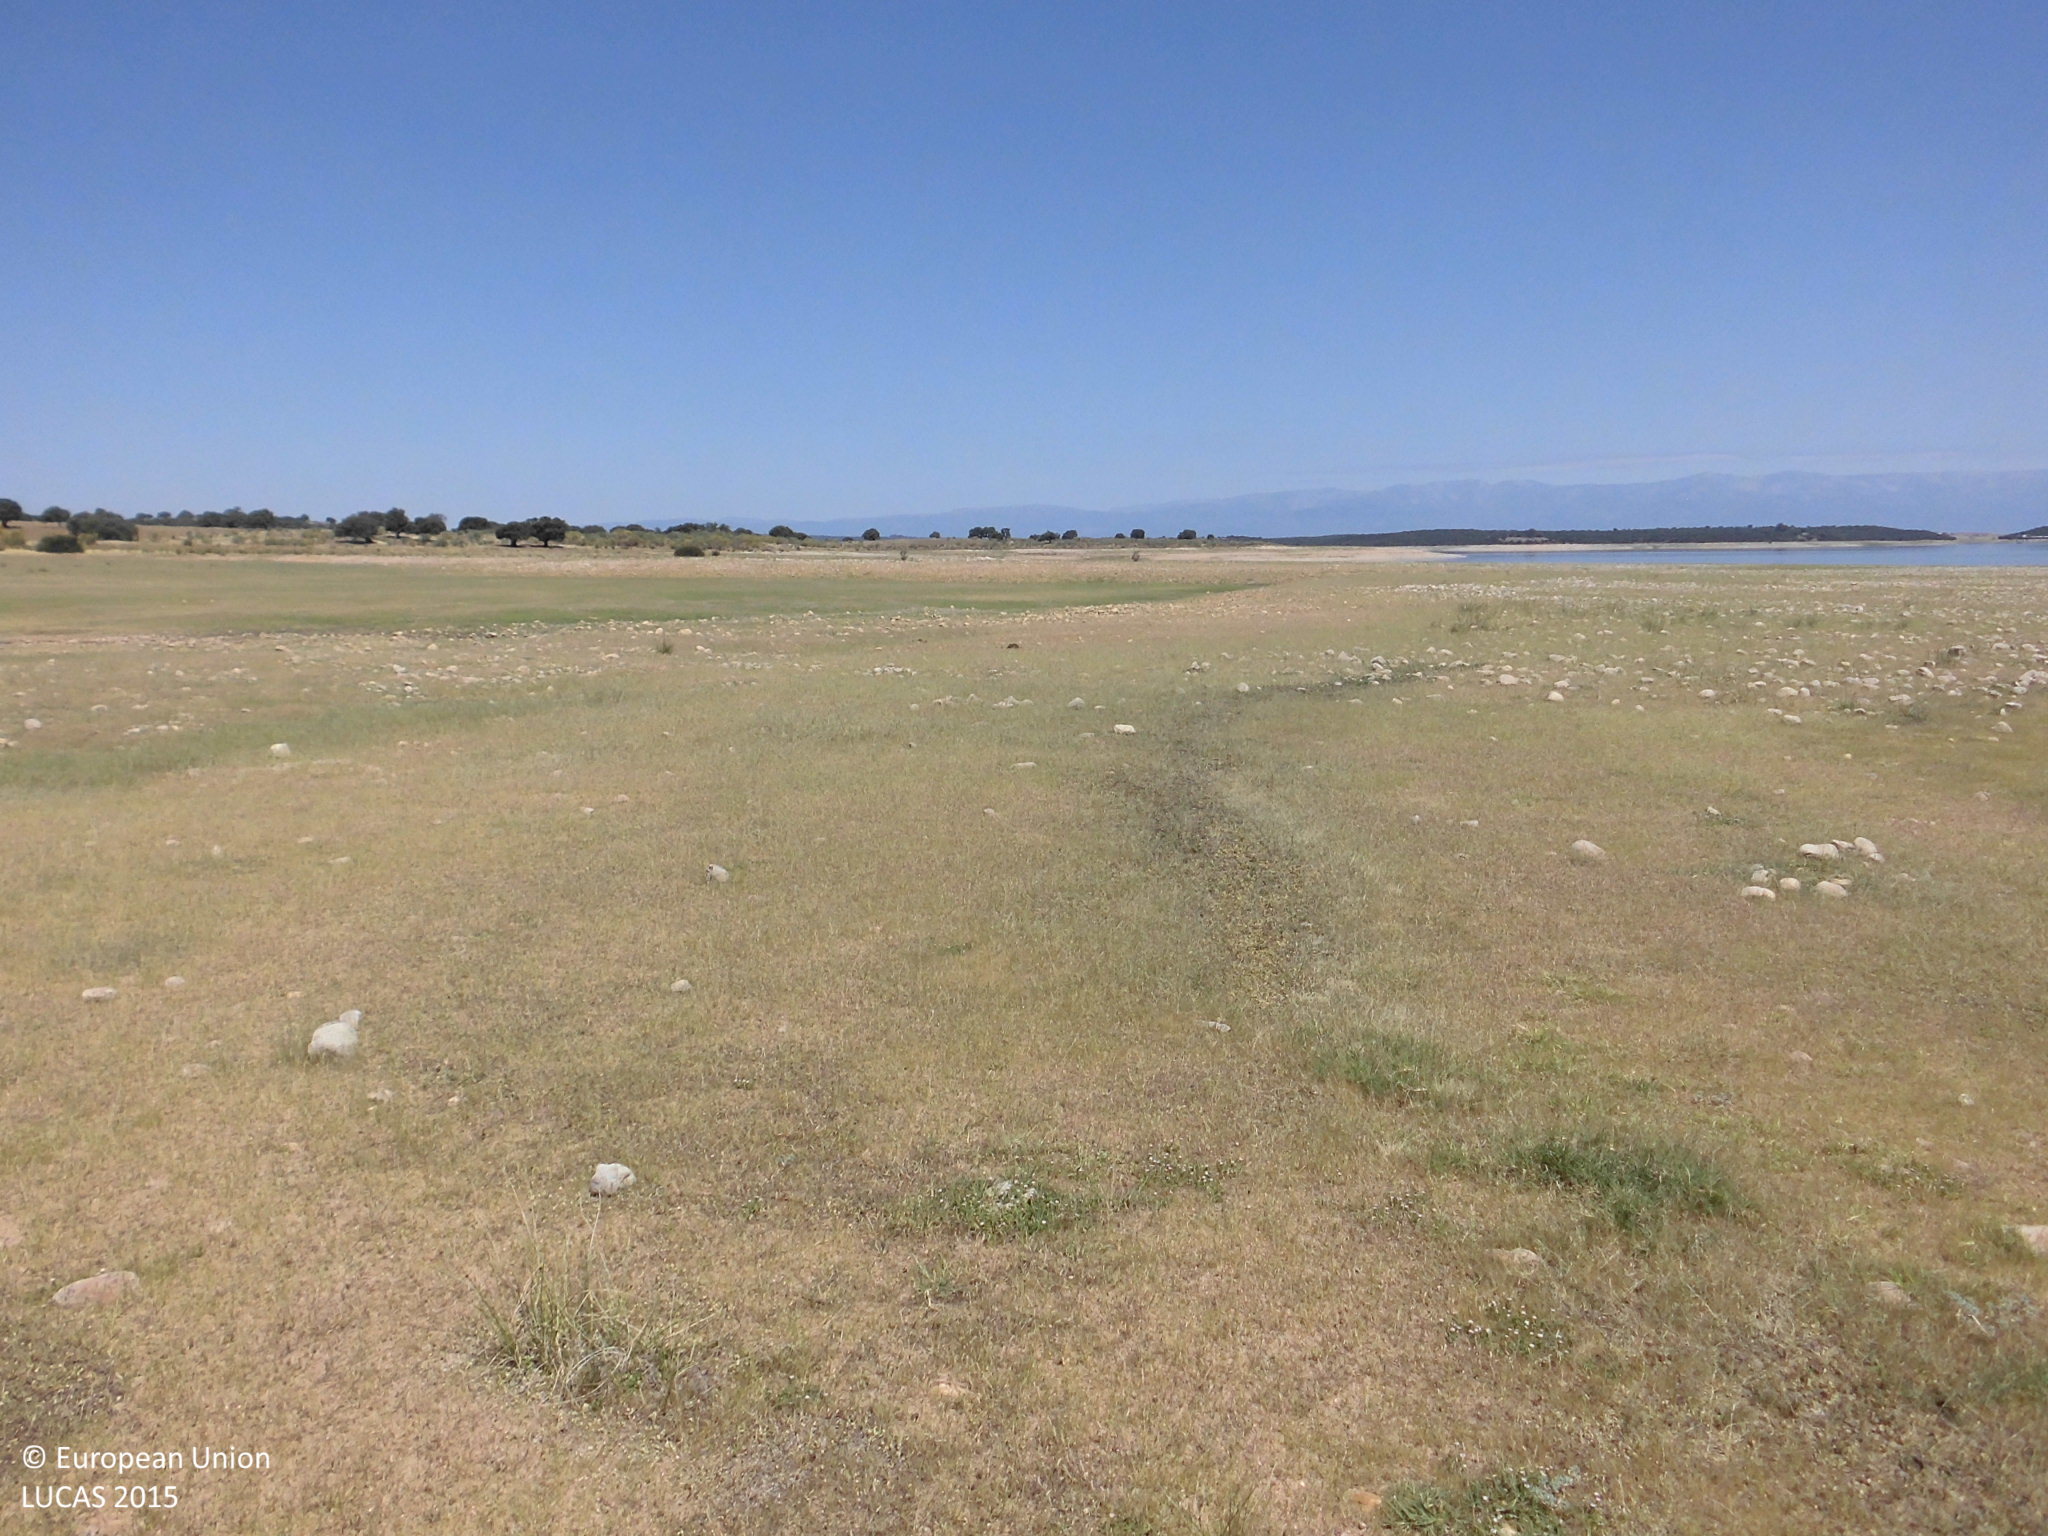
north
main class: Grassland
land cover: Spontaneously vegetated surfaces
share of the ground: > 75 %
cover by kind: herbaceous plants 100 %
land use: Semi-natural and natural areas not in use
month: July
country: ES
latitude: 39.7876
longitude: -5.4579
